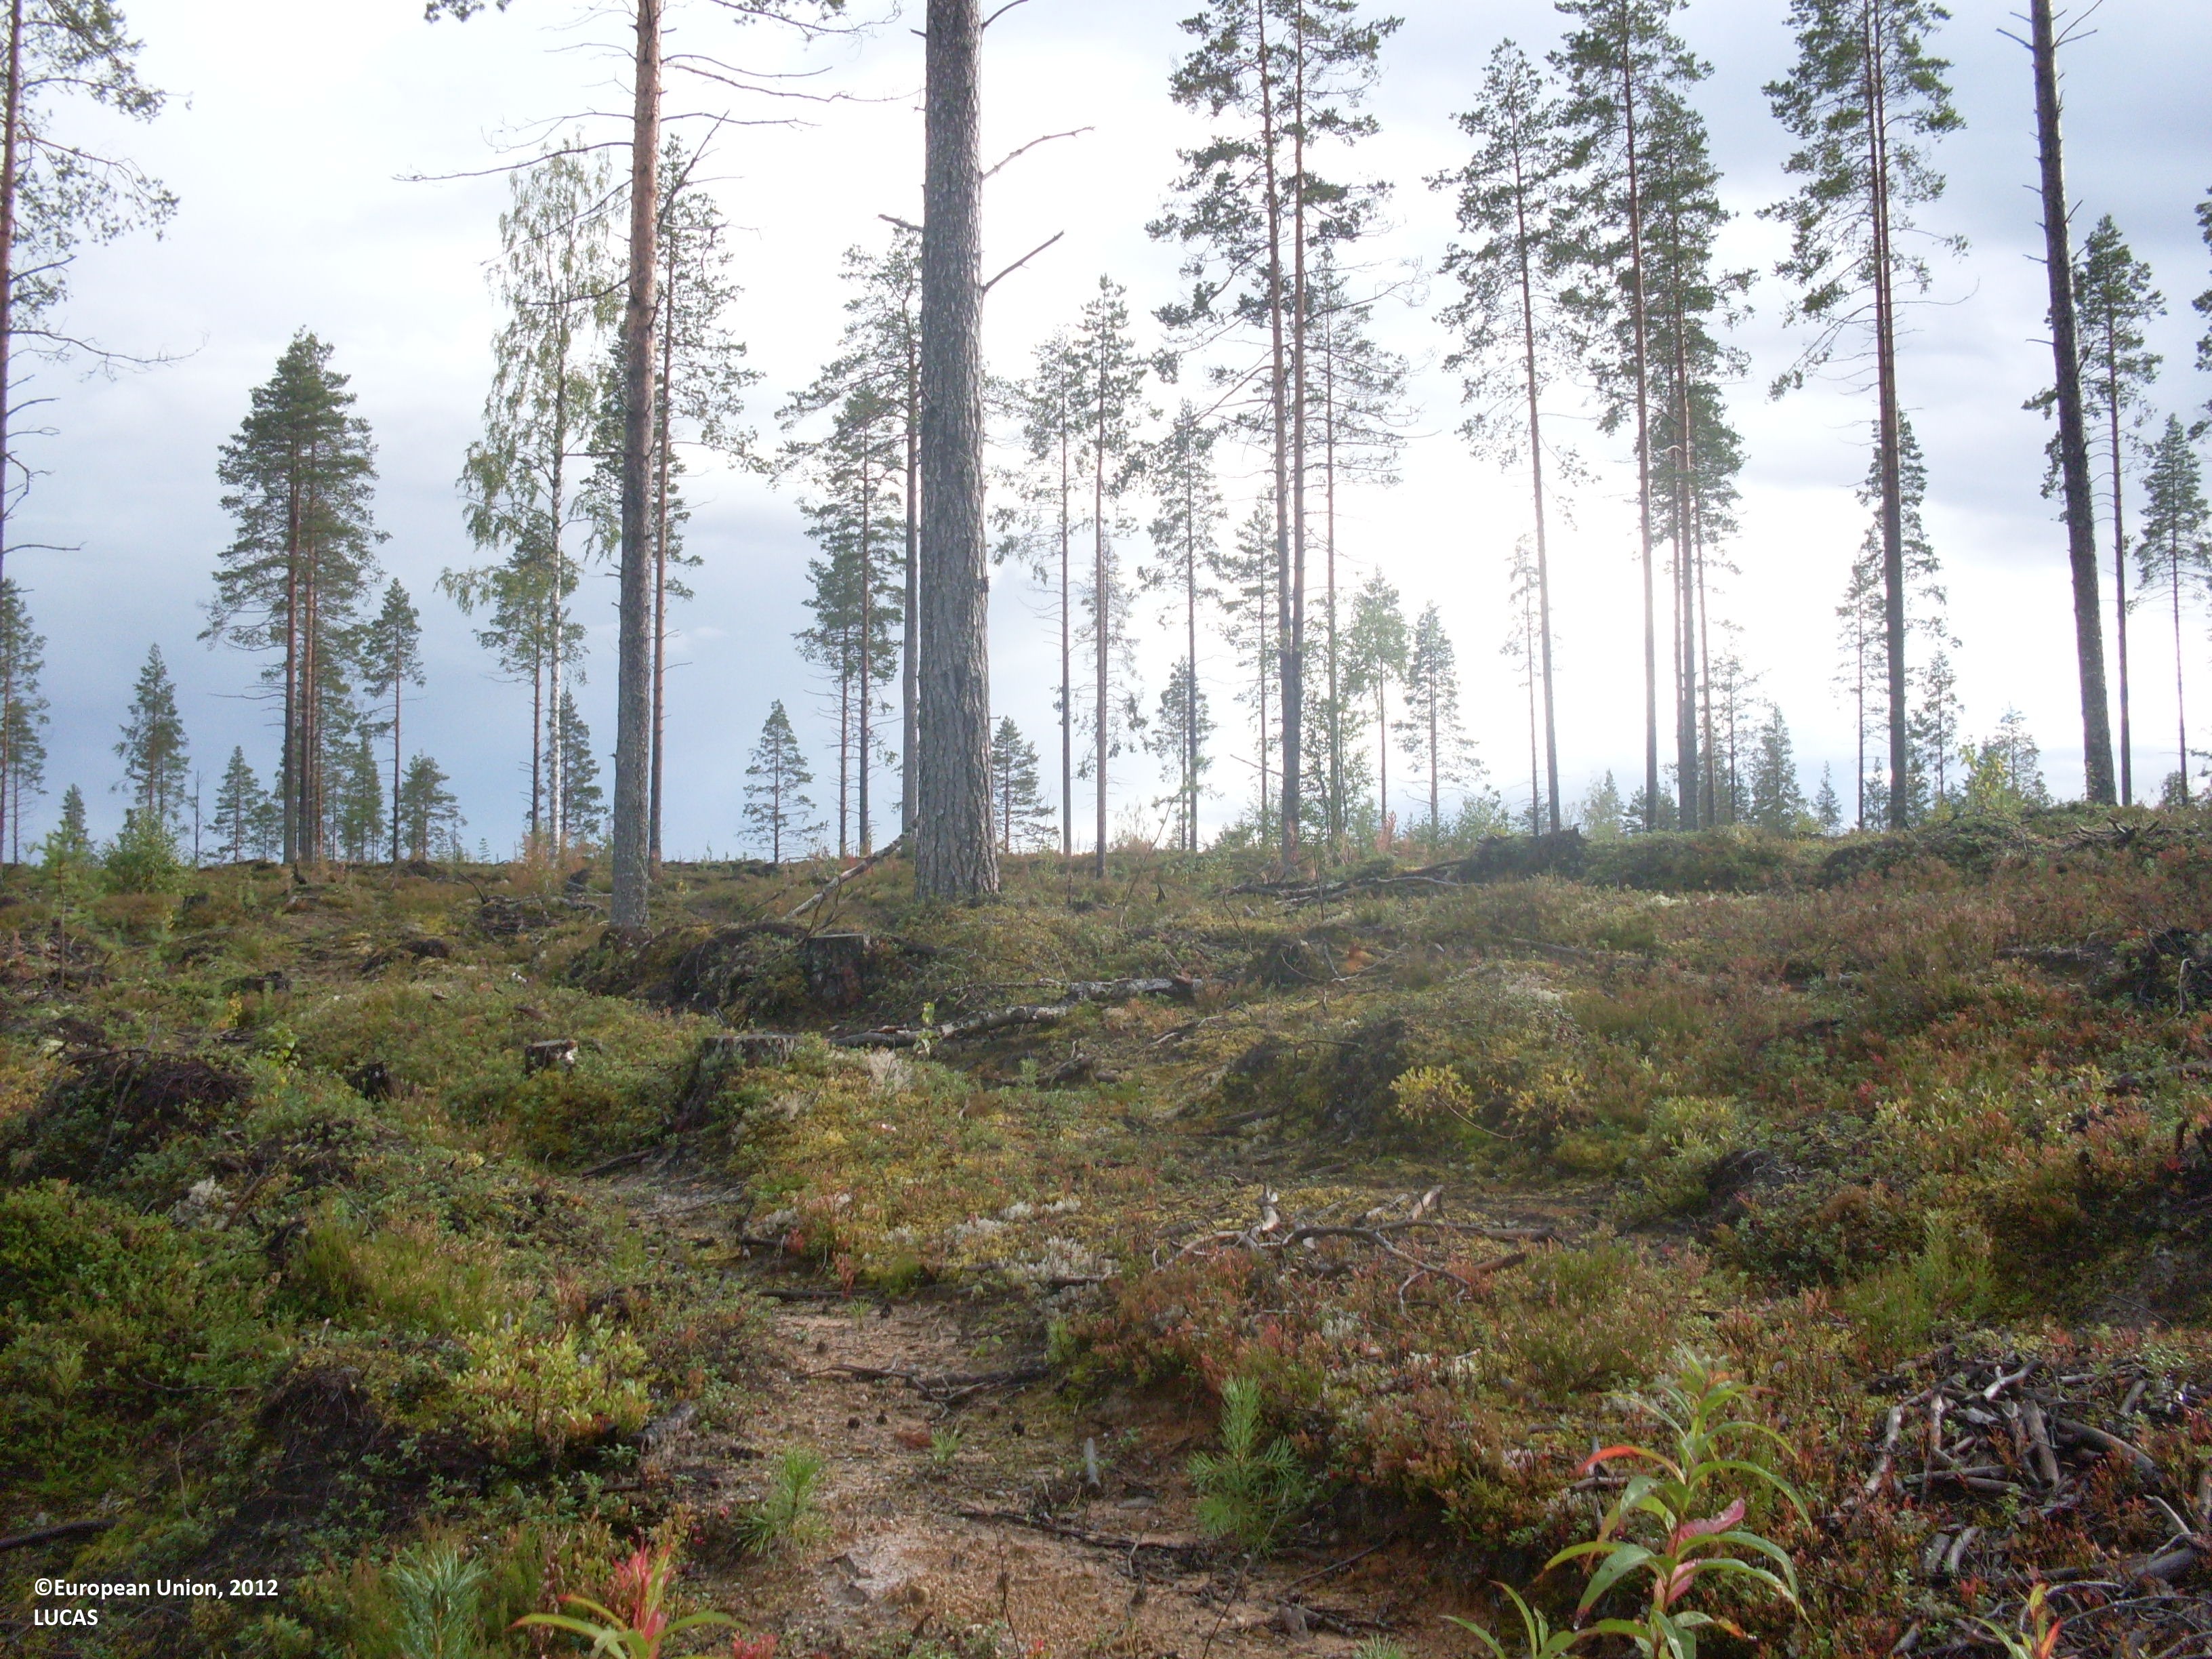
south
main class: Woodland
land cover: Pine dominated coniferous woodland
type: boreal forest
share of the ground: 10 - 25 %
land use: Forestry
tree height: < 5 m
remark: Nursery
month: September
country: FI
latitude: 64.1570
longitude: 29.8264
